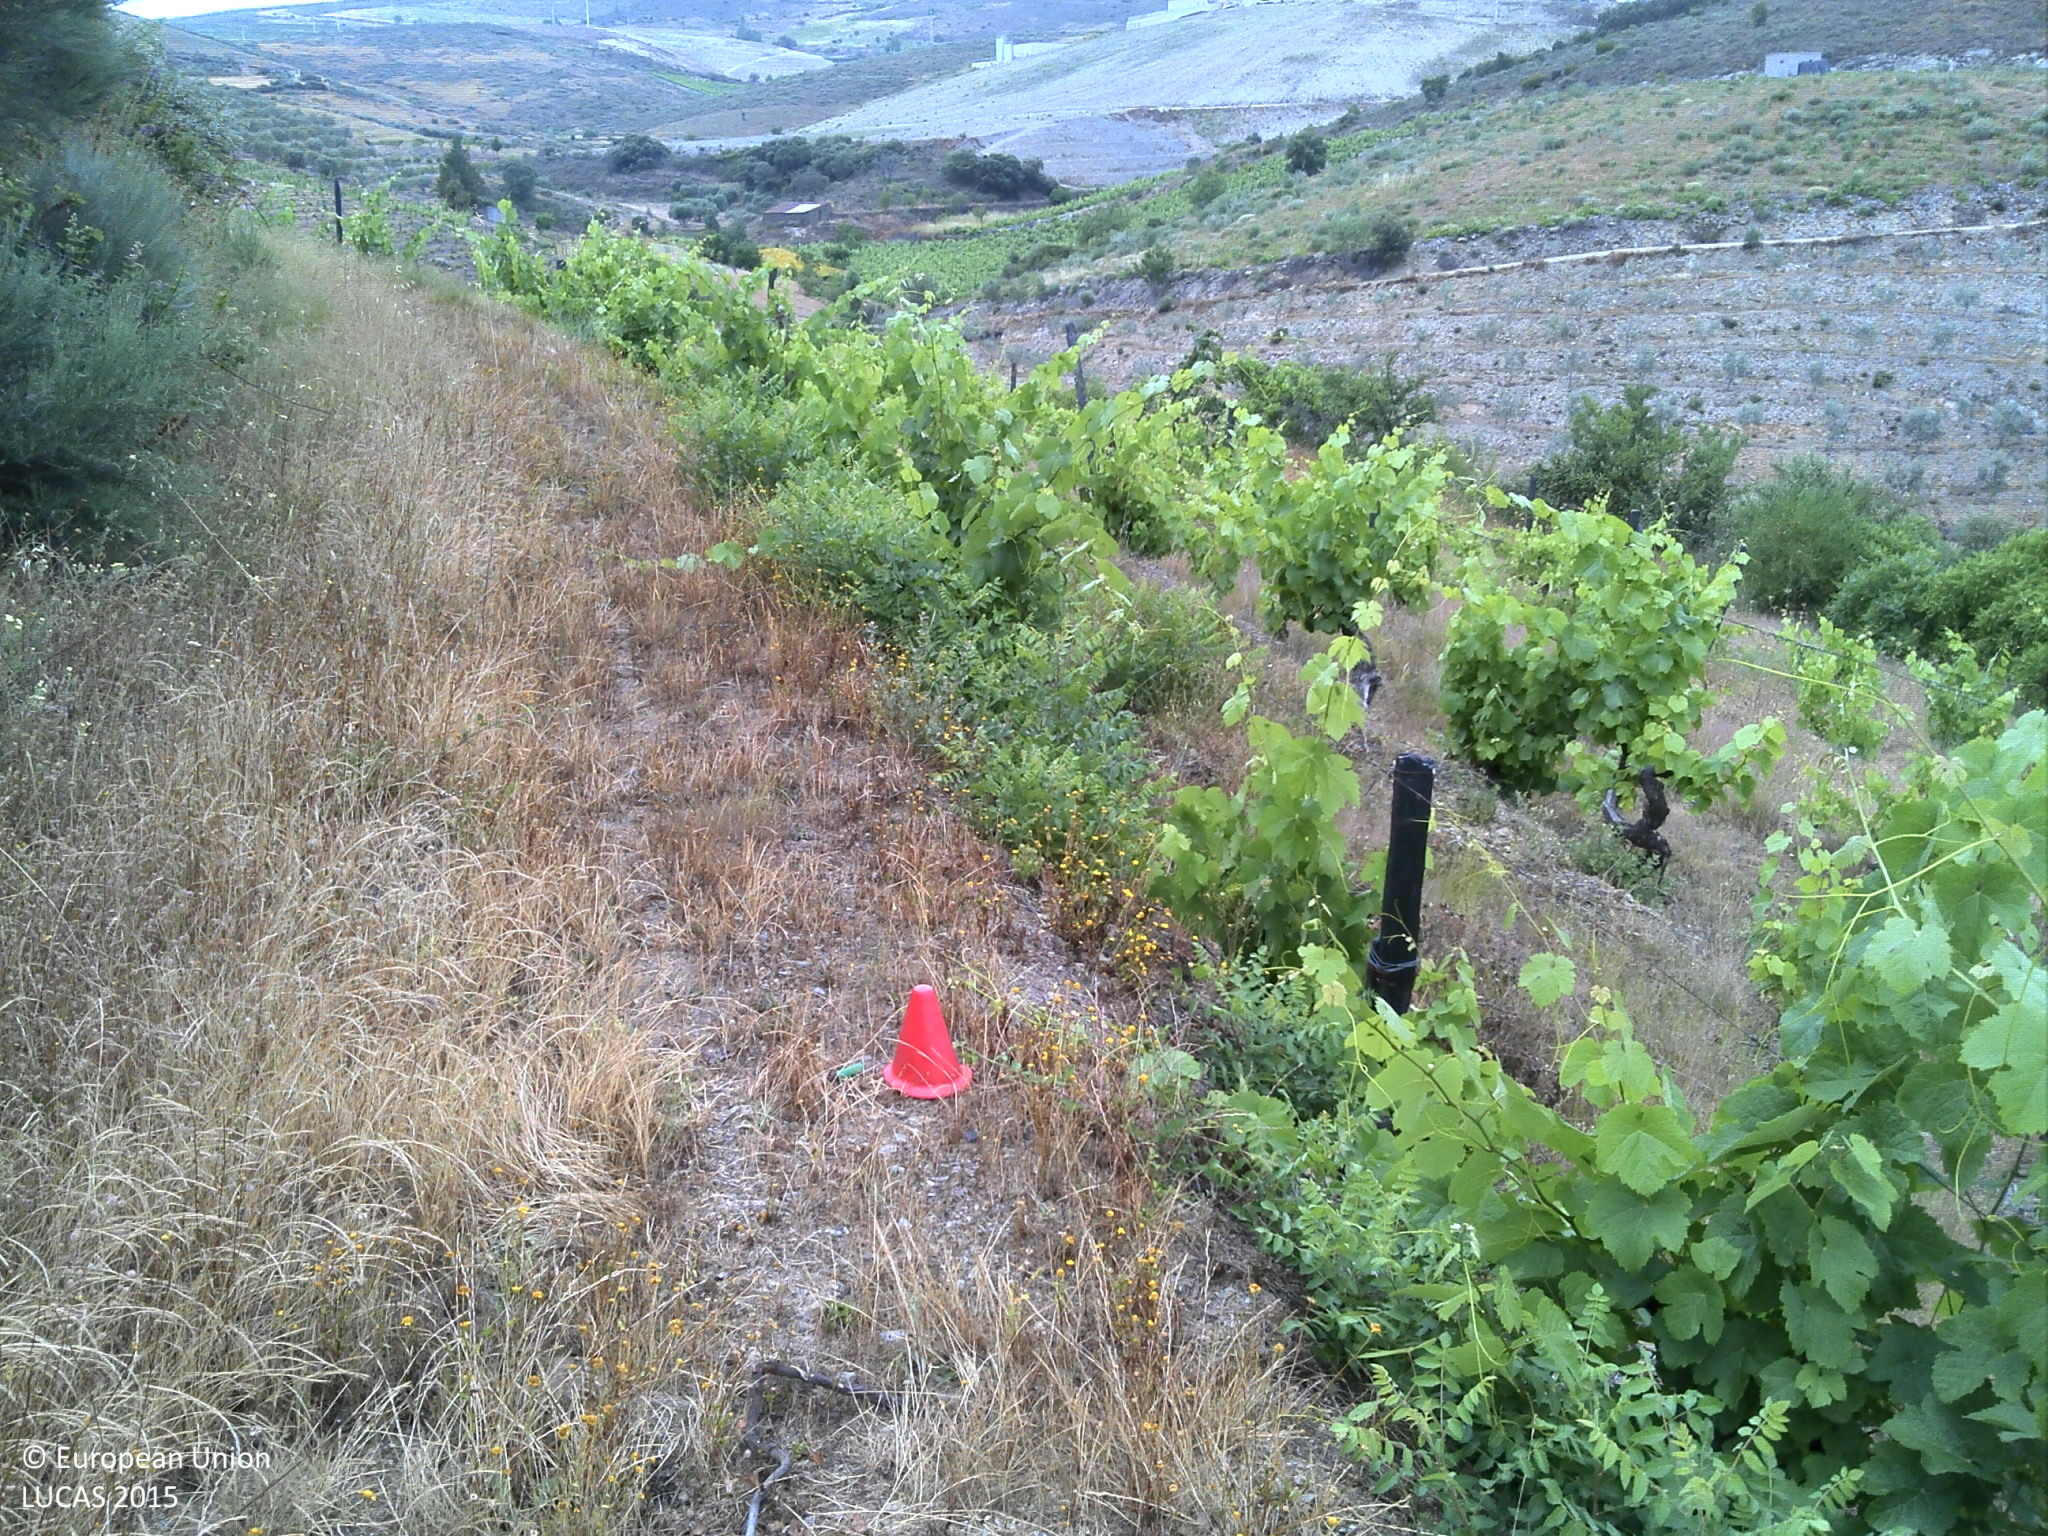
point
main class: Cropland
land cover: Vineyards
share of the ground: < 10 %
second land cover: Spontaneously vegetated surfaces
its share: 10 - 25 %
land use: Agriculture (excluding fallow land and kitchen gardens)
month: June
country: PT
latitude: 41.1469
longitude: -7.4324
